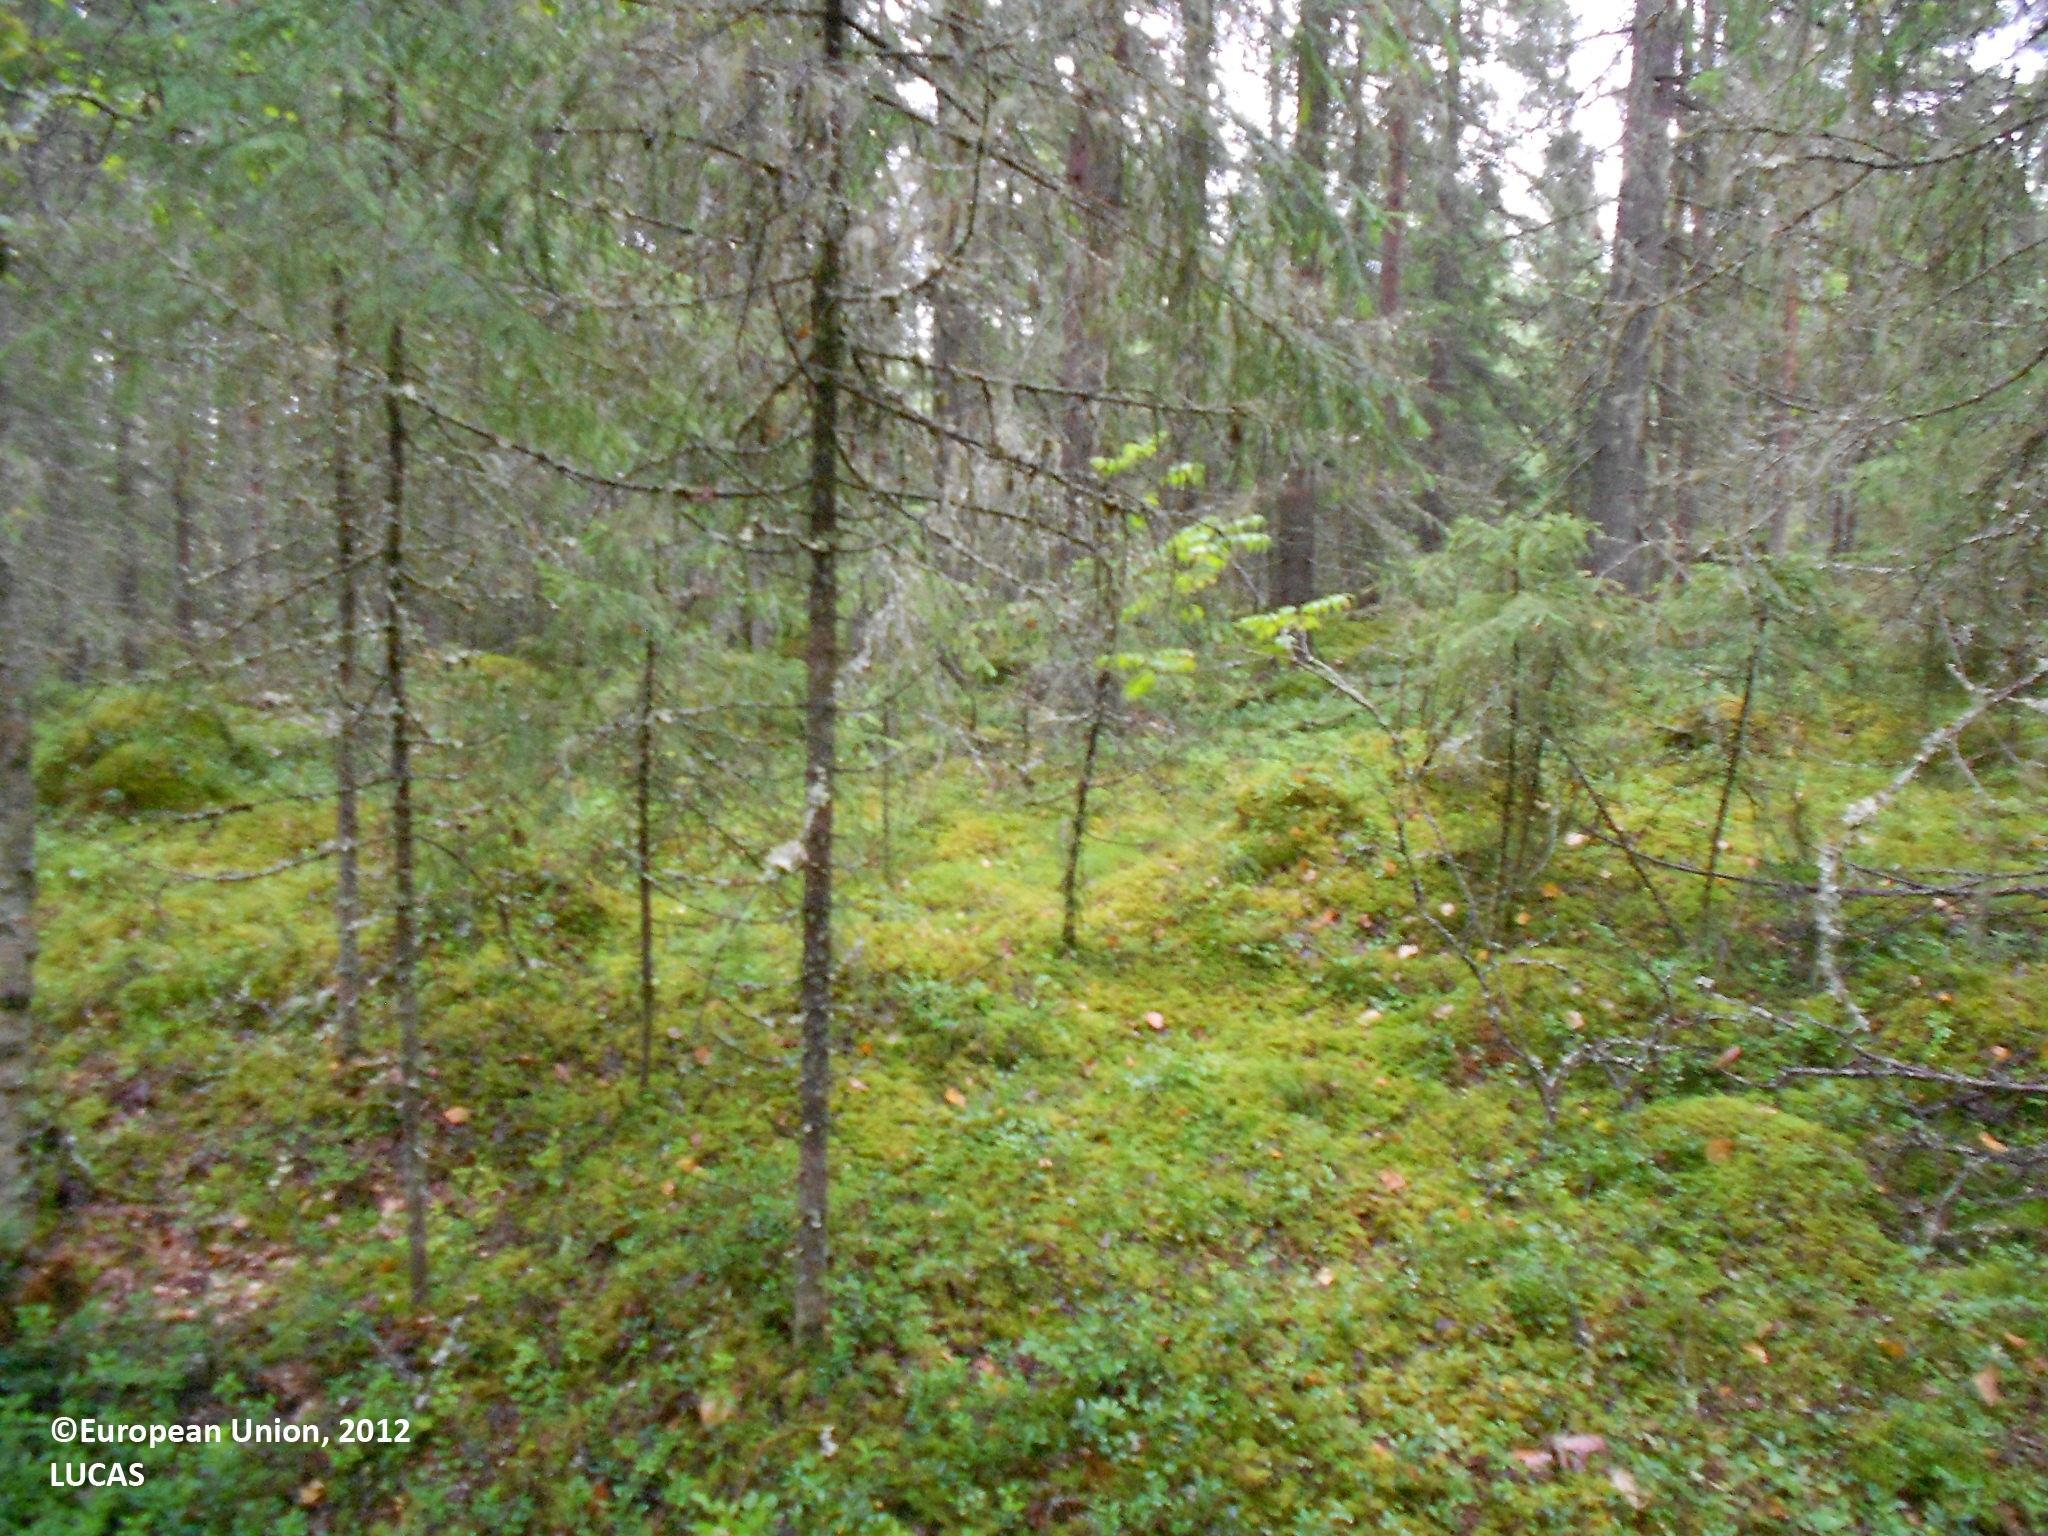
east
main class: Woodland
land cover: Spruce dominated coniferous woodland
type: boreal forest
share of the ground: > 75 %
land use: Forestry
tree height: > 5 m
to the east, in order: Spruce dominated coniferous woodland; Pine dominated coniferous woodland; Spruce dominated mixed woodland
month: August
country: FI
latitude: 63.6133
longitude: 28.9398
